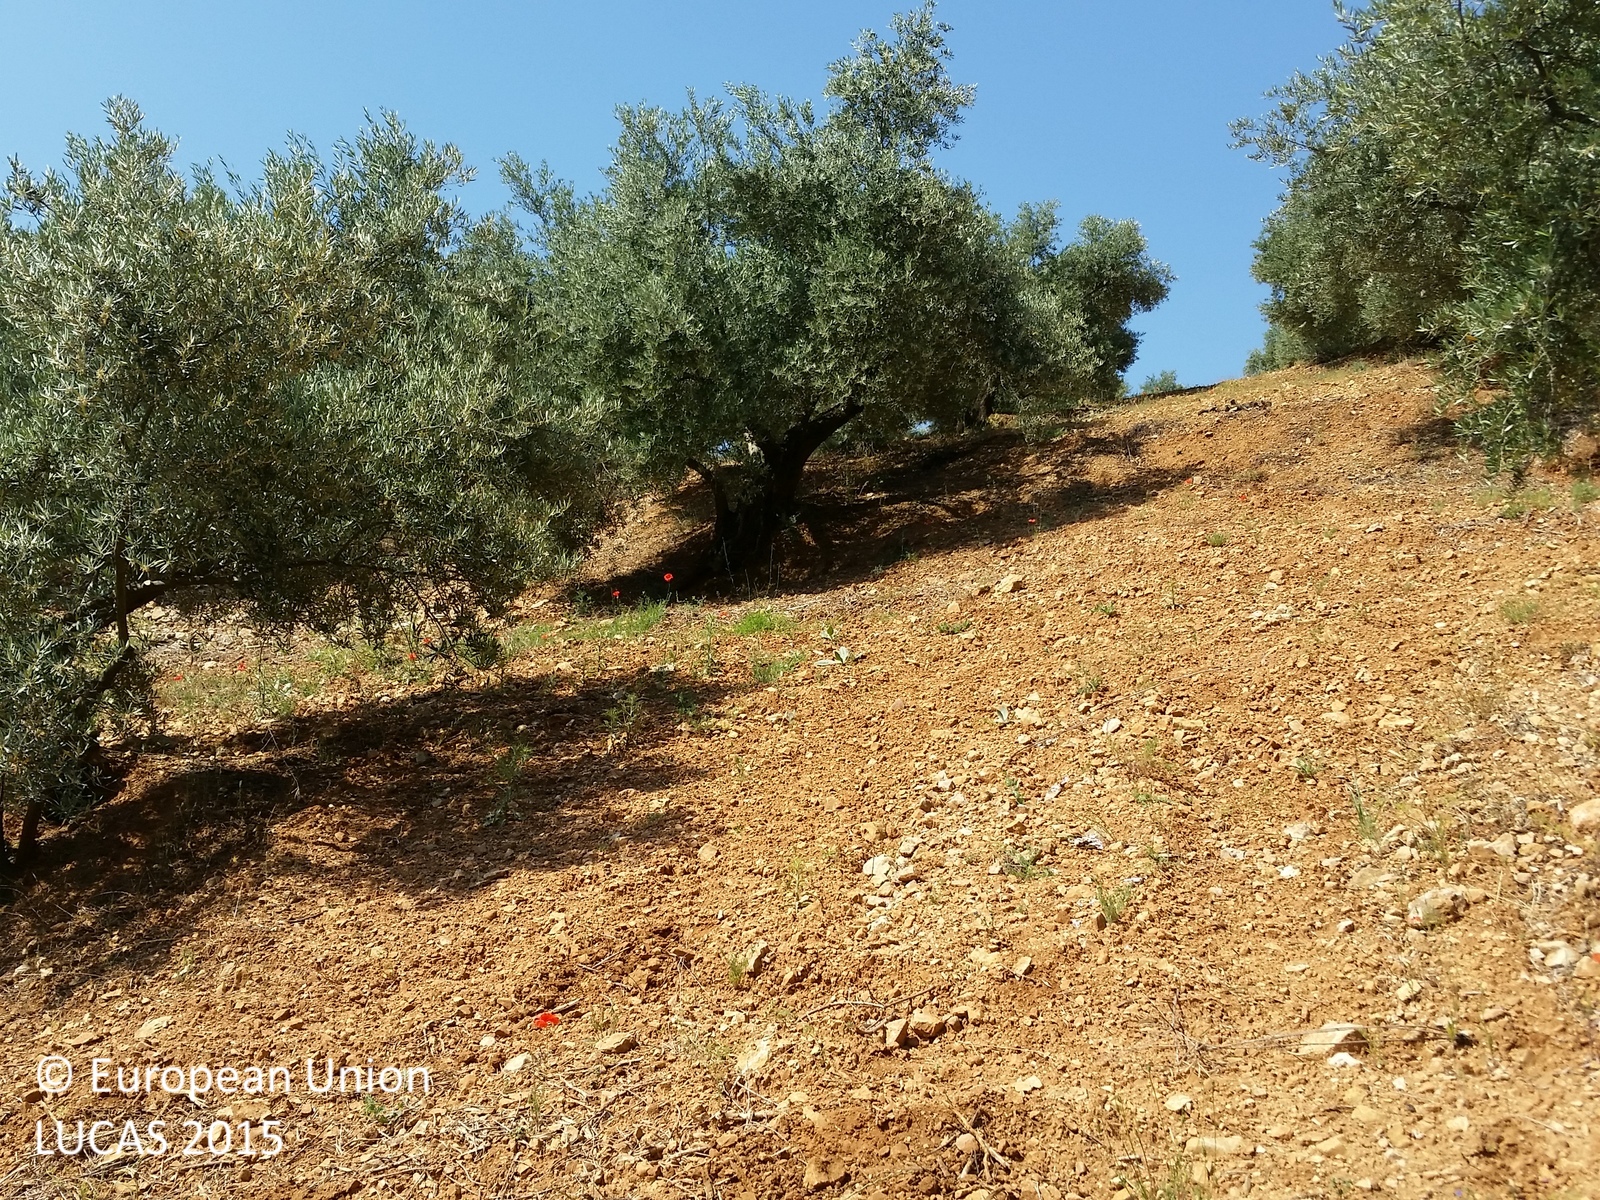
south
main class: Cropland
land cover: Olive groves
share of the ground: 50 - 75 %
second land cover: Spontaneously vegetated surfaces
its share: 10 - 25 %
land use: Agriculture (excluding fallow land and kitchen gardens)
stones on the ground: 10 - 25 %
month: June
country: ES
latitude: 38.4312
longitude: -2.5653
